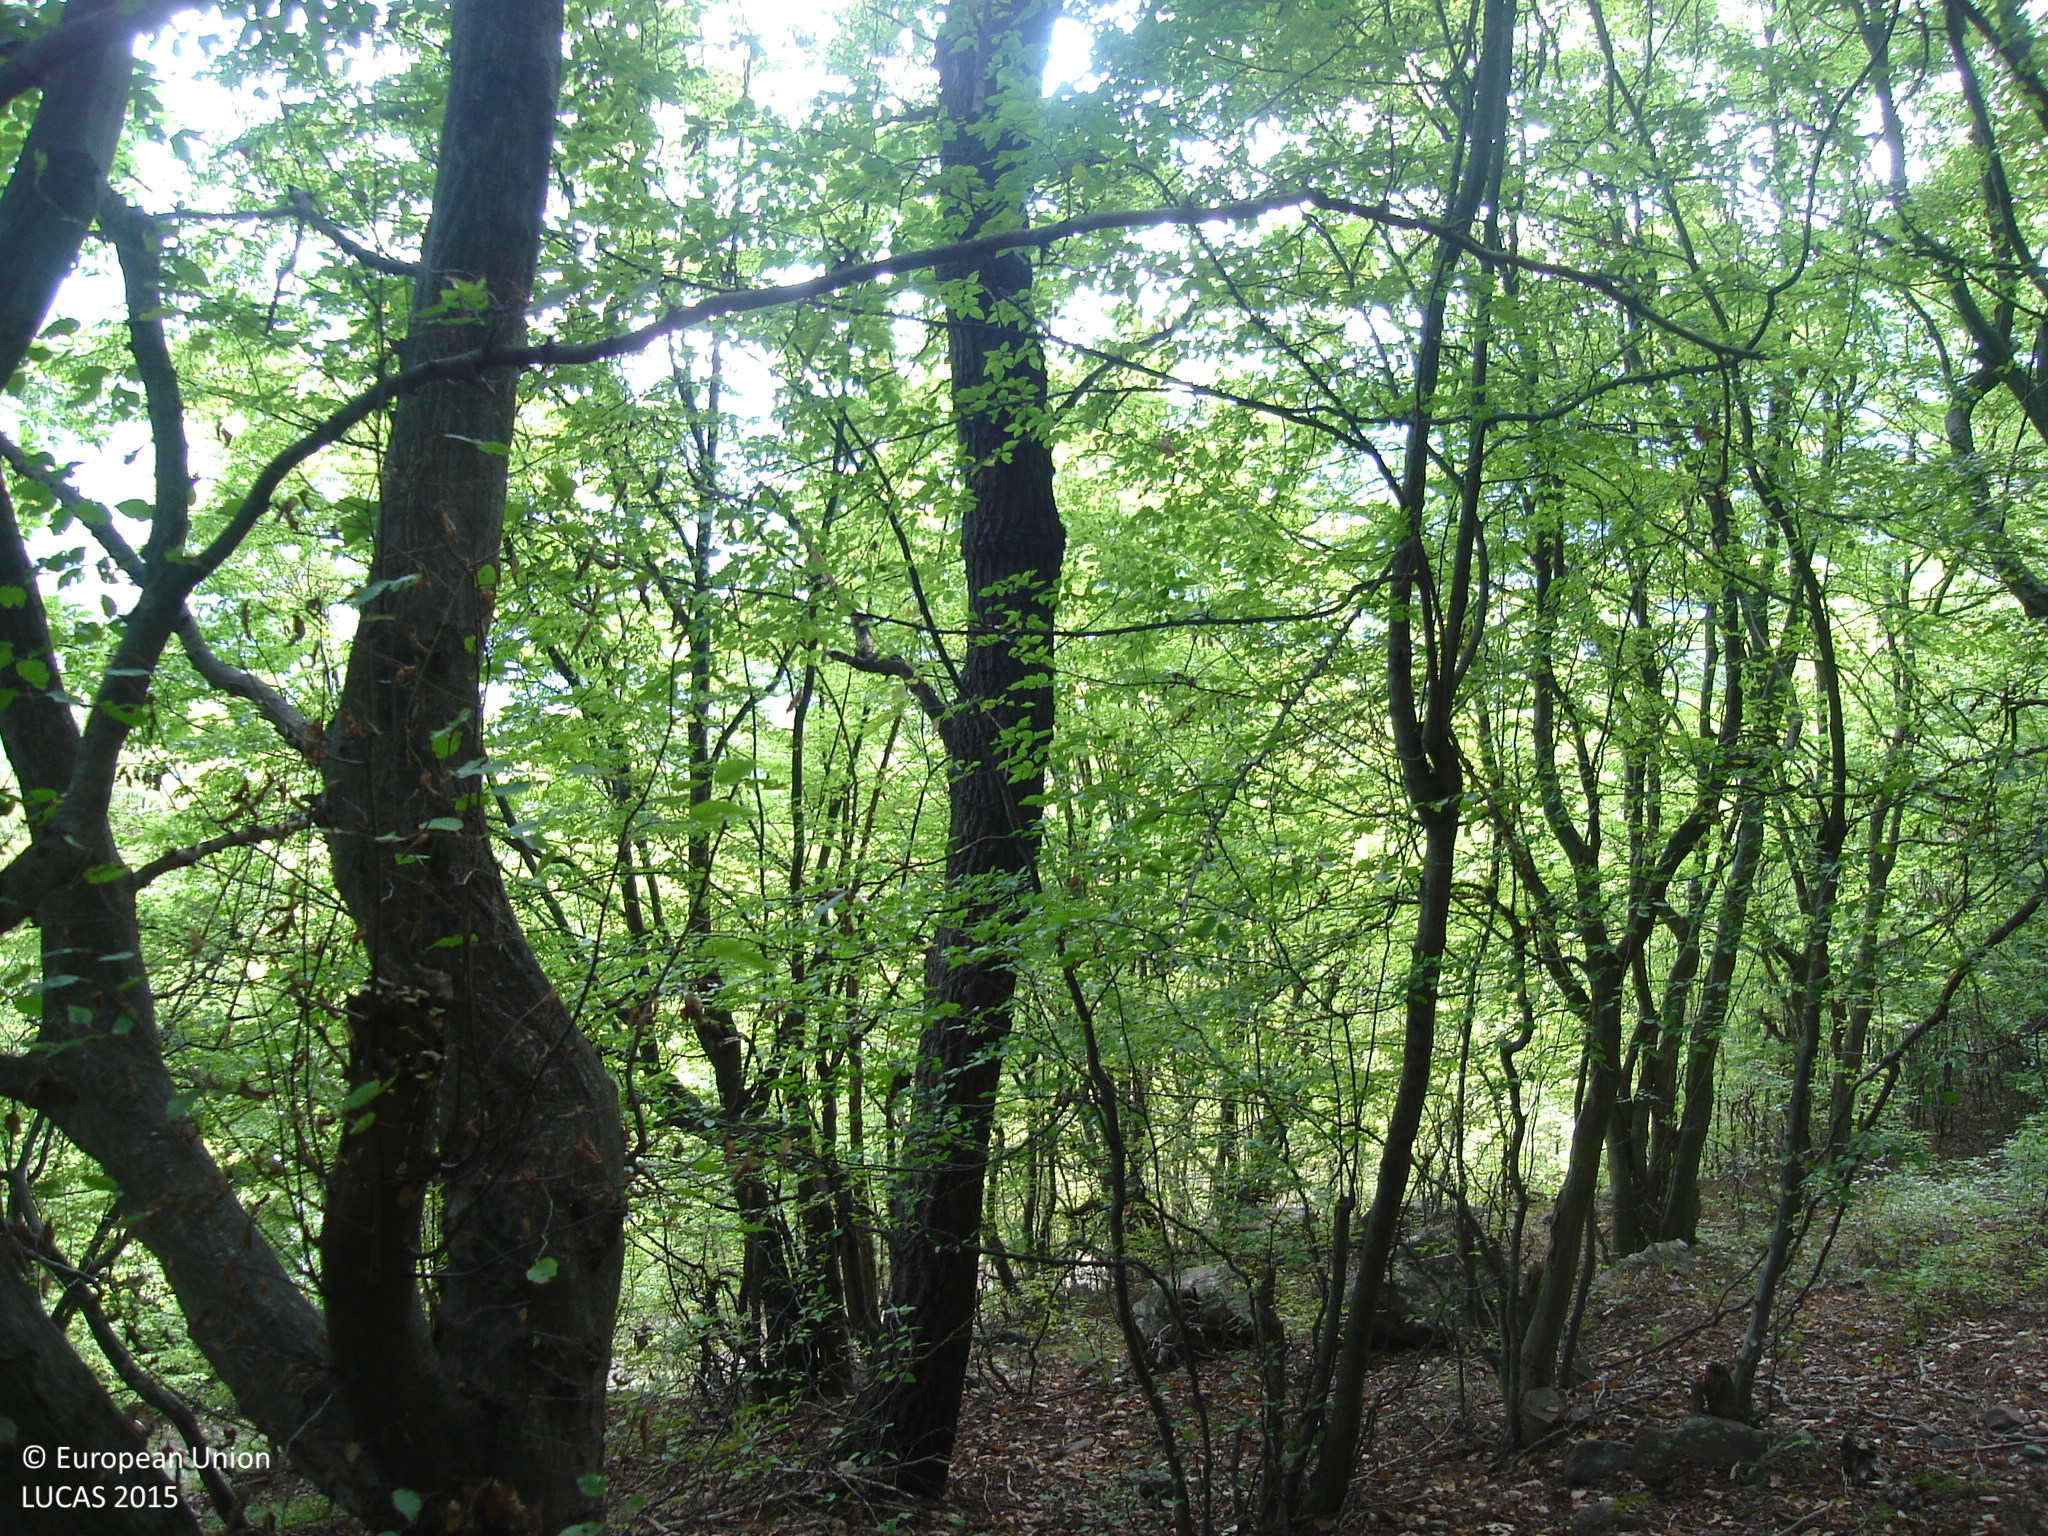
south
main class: Woodland
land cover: Broadleaved woodland
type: mesophytic deciduous forest
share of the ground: > 75 %
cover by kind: broadleaved forest trees 80 %, unconsolidated bare surface 20 %
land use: Forestry
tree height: > 5 m
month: October
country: BG
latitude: 43.0797
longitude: 23.3653
